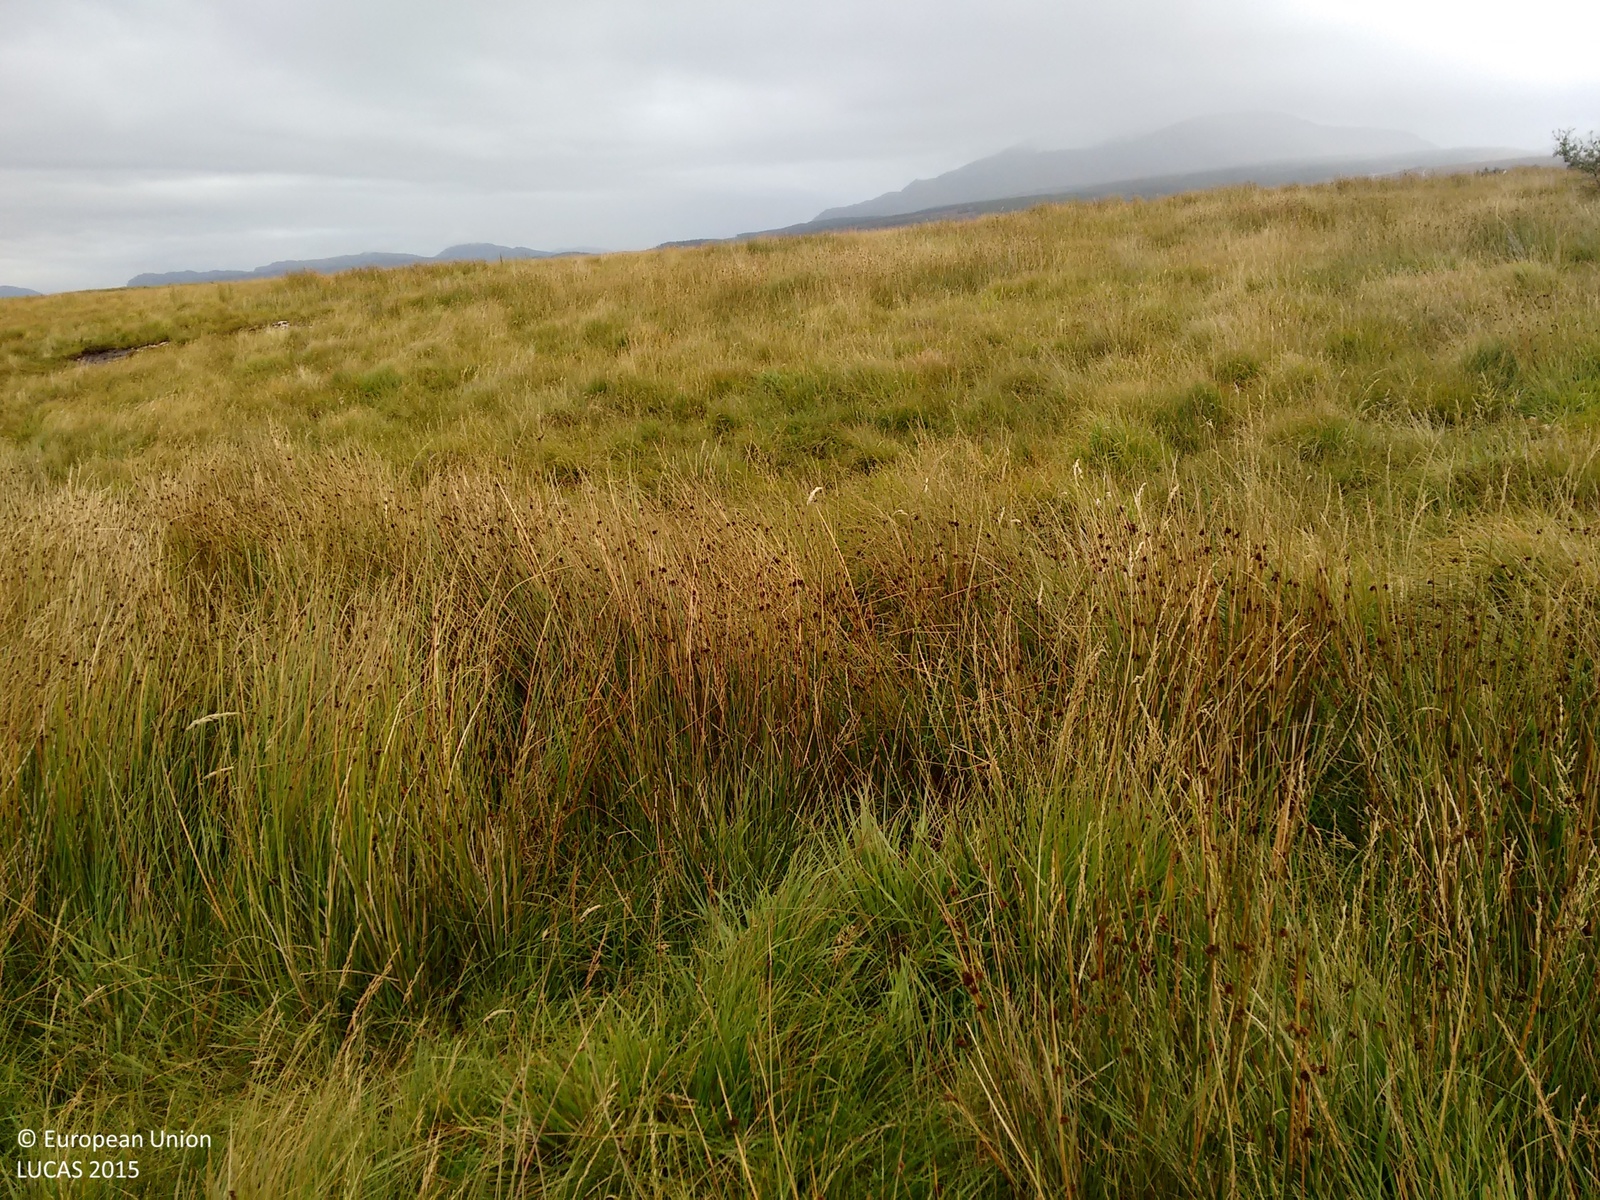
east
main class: Grassland
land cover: Grassland without tree/shrub cover
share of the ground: > 75 %
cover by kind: herbaceous plants 95 %, shrubs 5 %
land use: Agriculture (excluding fallow land and kitchen gardens)
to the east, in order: Grassland without tree/shrub cover; Shrubland without tree cover; Rocks and stones; Grassland without tree/shrub cover; Salt marshes; Grassland without tree/shrub cover
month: September
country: GB
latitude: 57.2507
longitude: -5.8548
